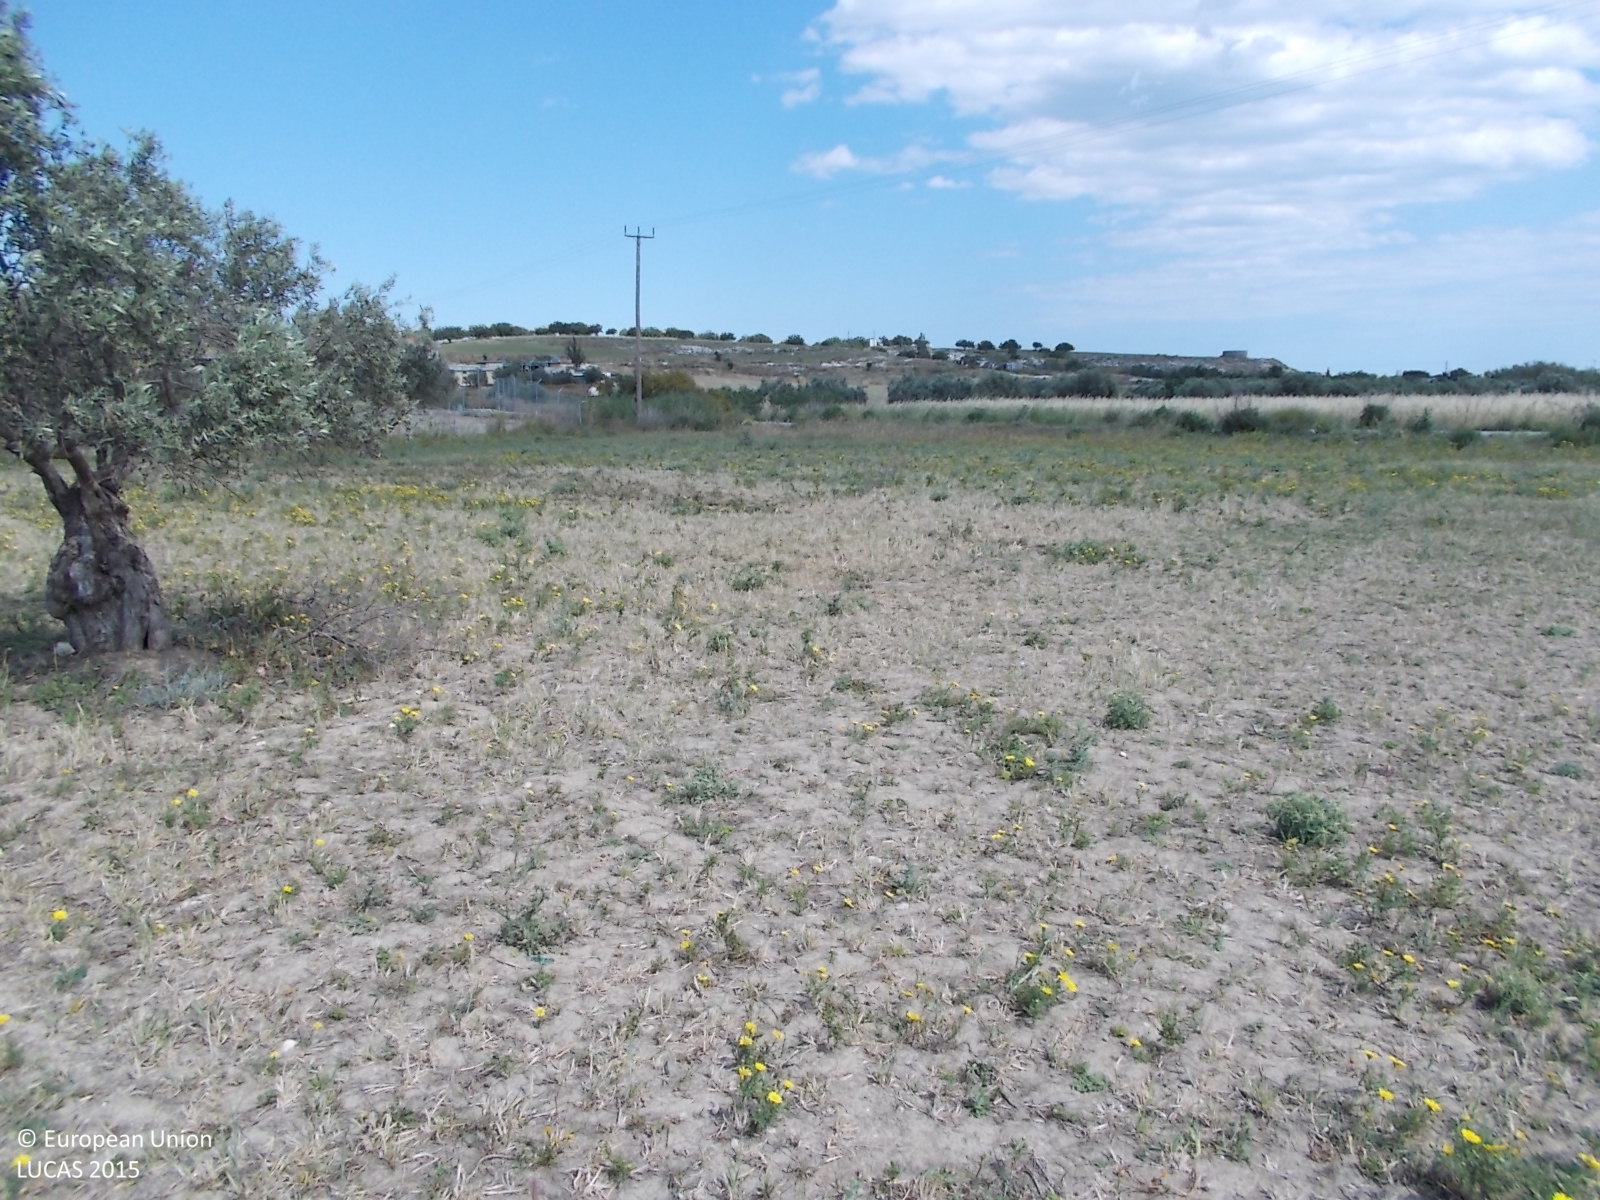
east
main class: Grassland
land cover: Grassland with sparse tree/shrub cover
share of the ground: 10 - 25 %
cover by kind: unconsolidated bare surface 80 %, herbaceous plants 15 %, broadleaved forest trees 5 %
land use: Agriculture (excluding fallow land and kitchen gardens)
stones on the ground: < 10 %
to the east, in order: Grassland with sparse tree/shrub cover; Electric lines; Abandoned hedges; Paved roads, cycling and walking lanes; Abandoned hedges; Single bushes/trees; Abandoned hedges; Grassland without tree/shrub cover; Olive groves; Tracks; Nuts trees; Common wheat
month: April
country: CY
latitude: 34.9986
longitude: 33.6585
